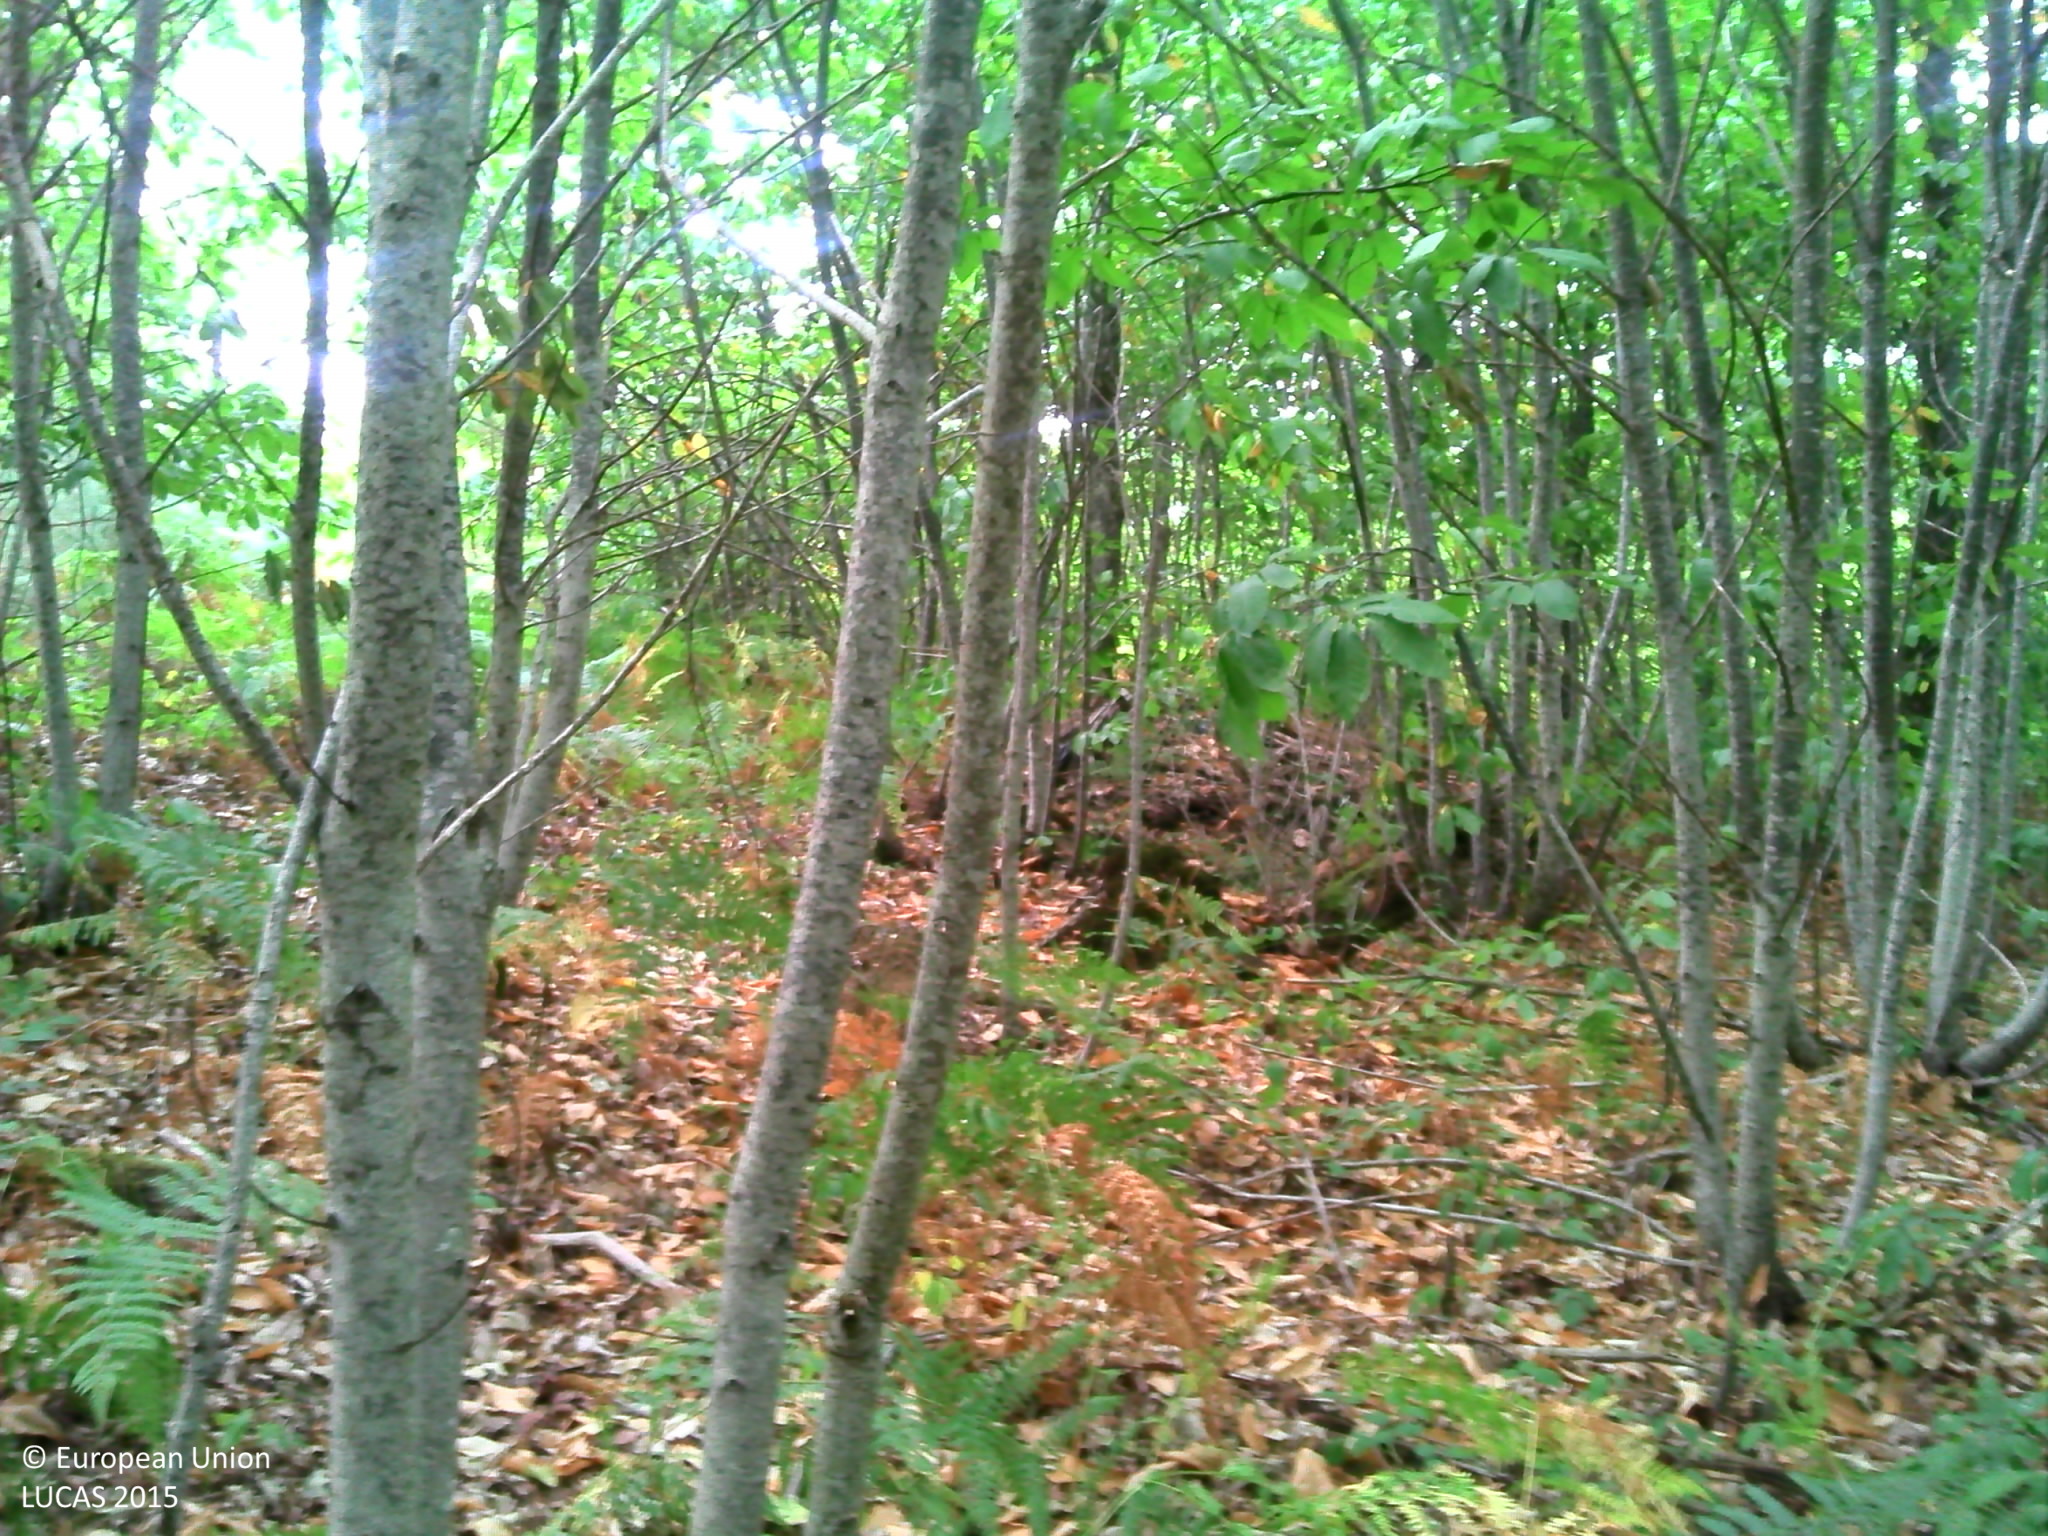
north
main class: Woodland
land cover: Broadleaved woodland
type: mesophytic deciduous forest
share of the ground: > 75 %
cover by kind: broadleaved forest trees 70 %, herbaceous plants 10 %, lichens and mosses 10 %, unconsolidated bare surface 10 %
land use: Forestry
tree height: > 5 m
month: July
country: FR
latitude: 45.6292
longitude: 0.6107
